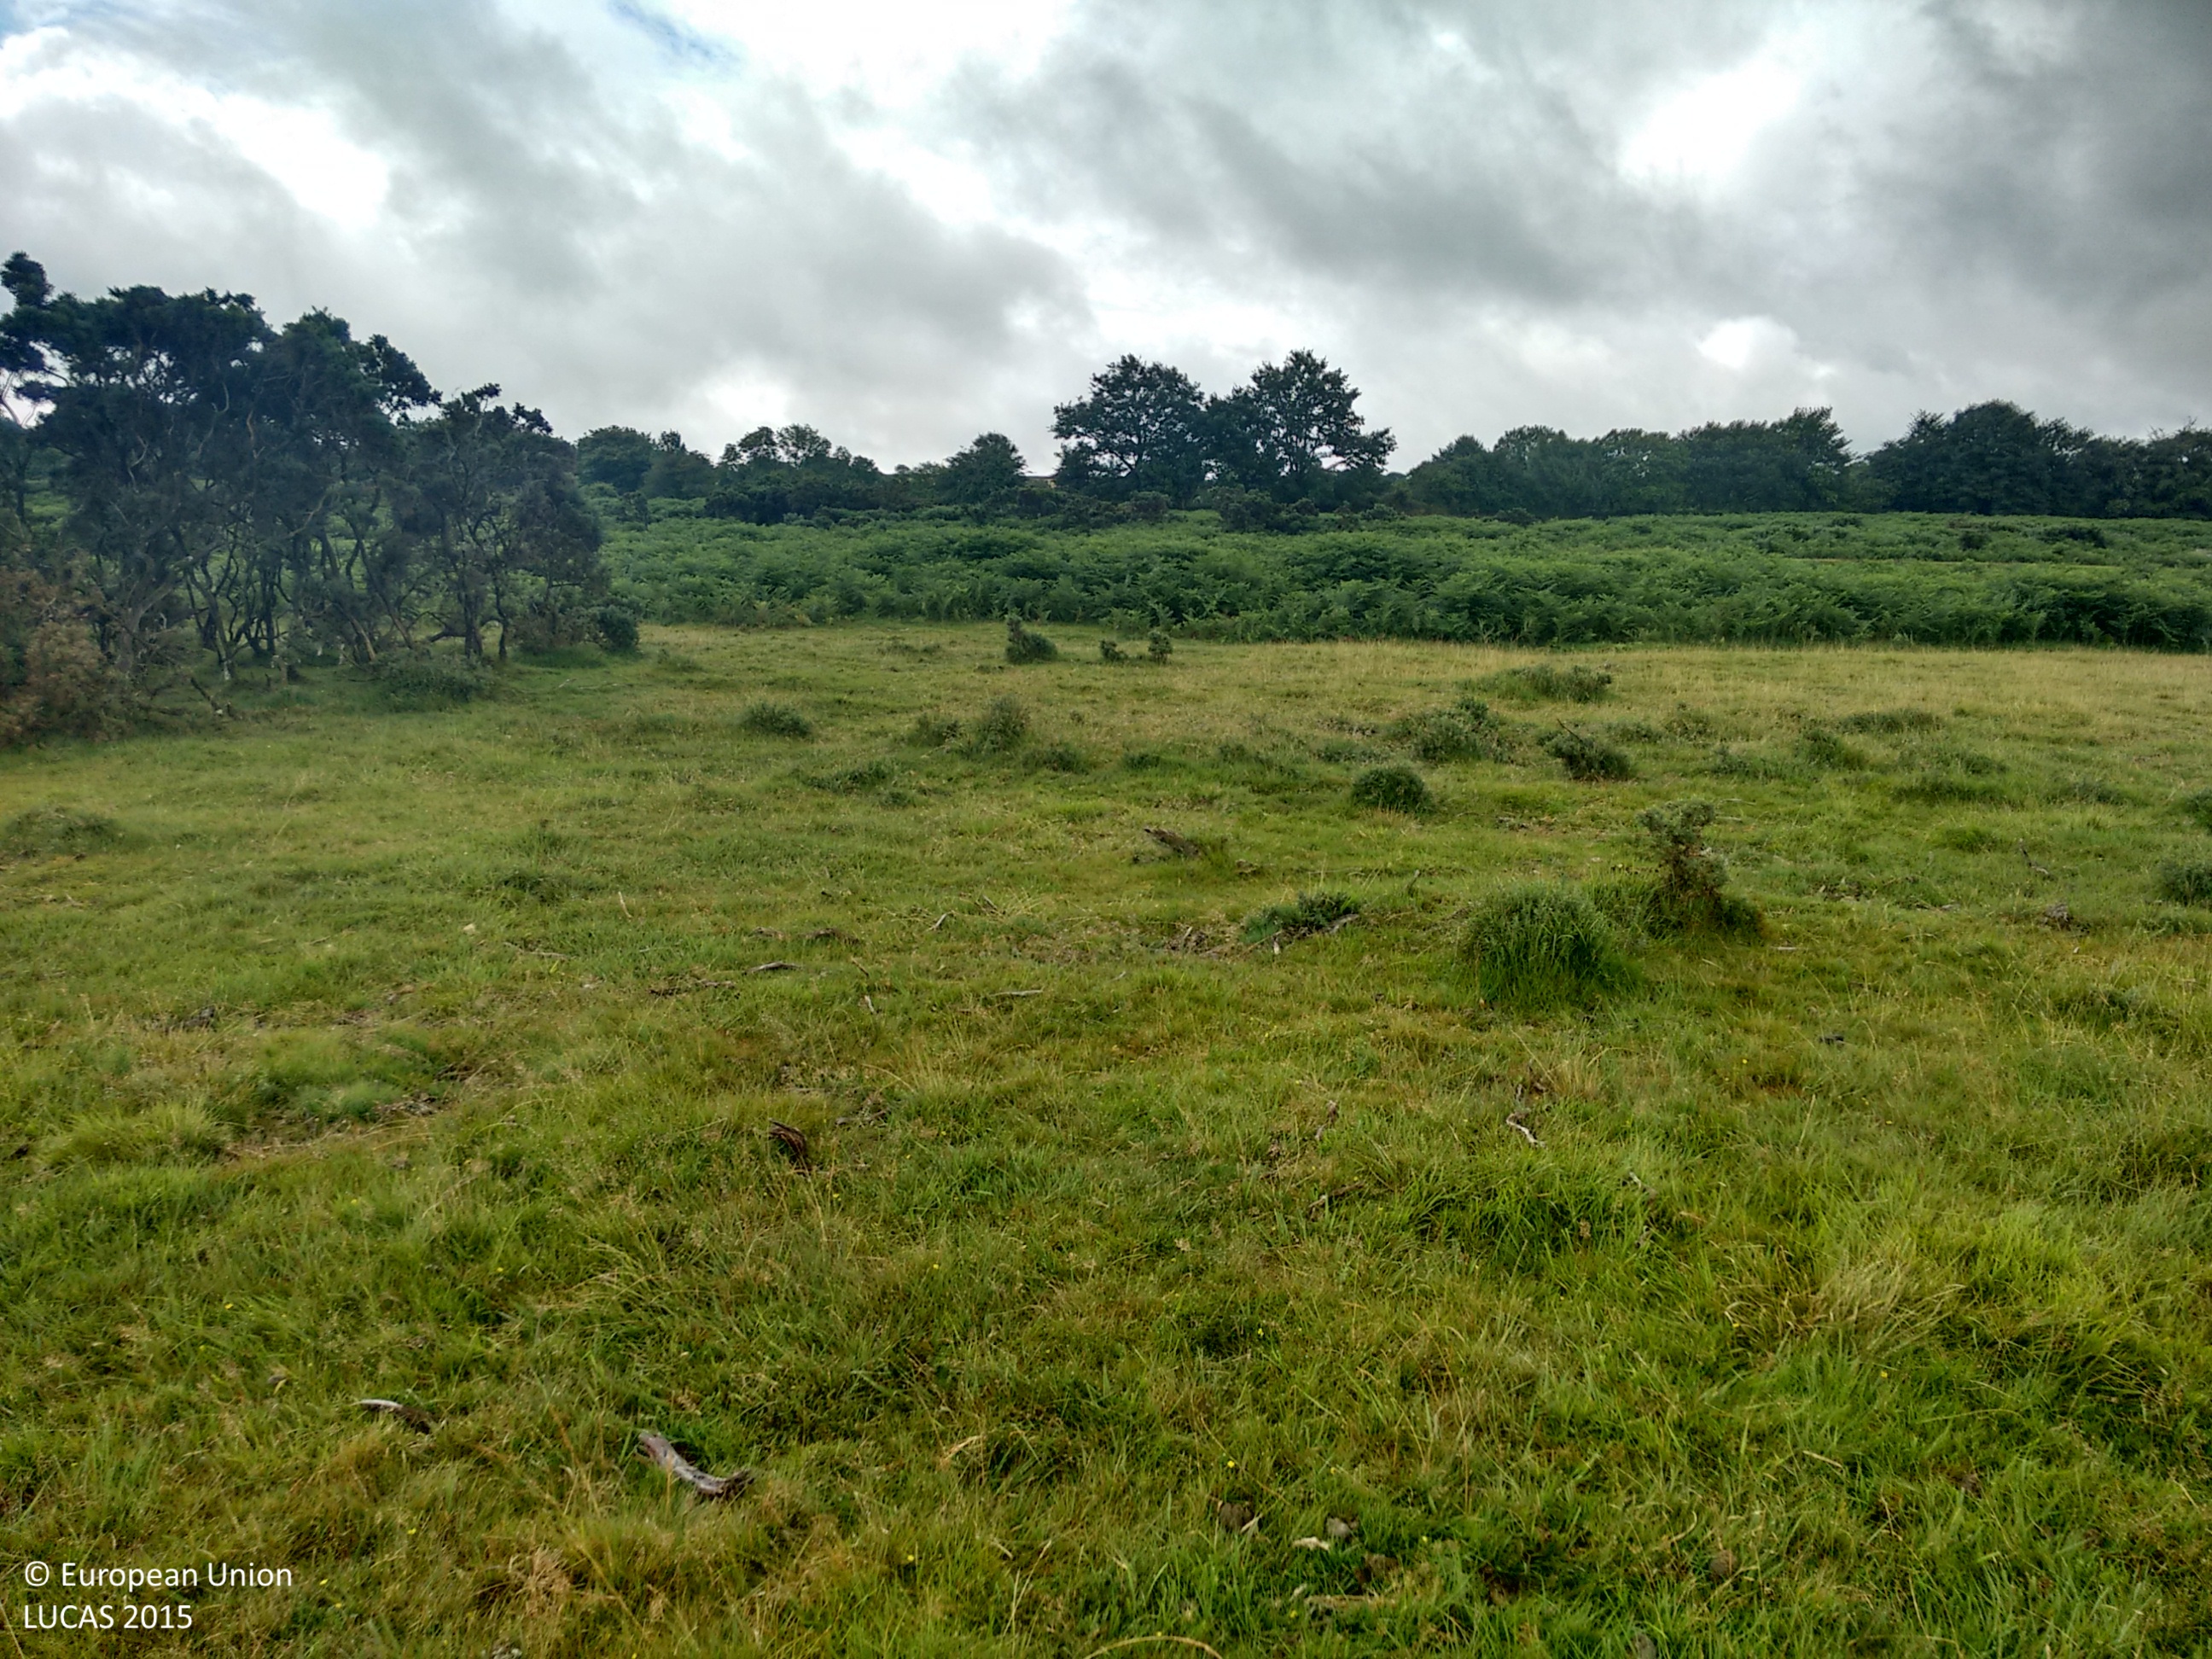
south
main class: Shrubland
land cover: Shrubland without tree cover
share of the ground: > 75 %
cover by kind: herbaceous plants 75 %, shrubs 25 %
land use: Agriculture (excluding fallow land and kitchen gardens)
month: August
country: GB
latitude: 50.5429
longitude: -4.1084
